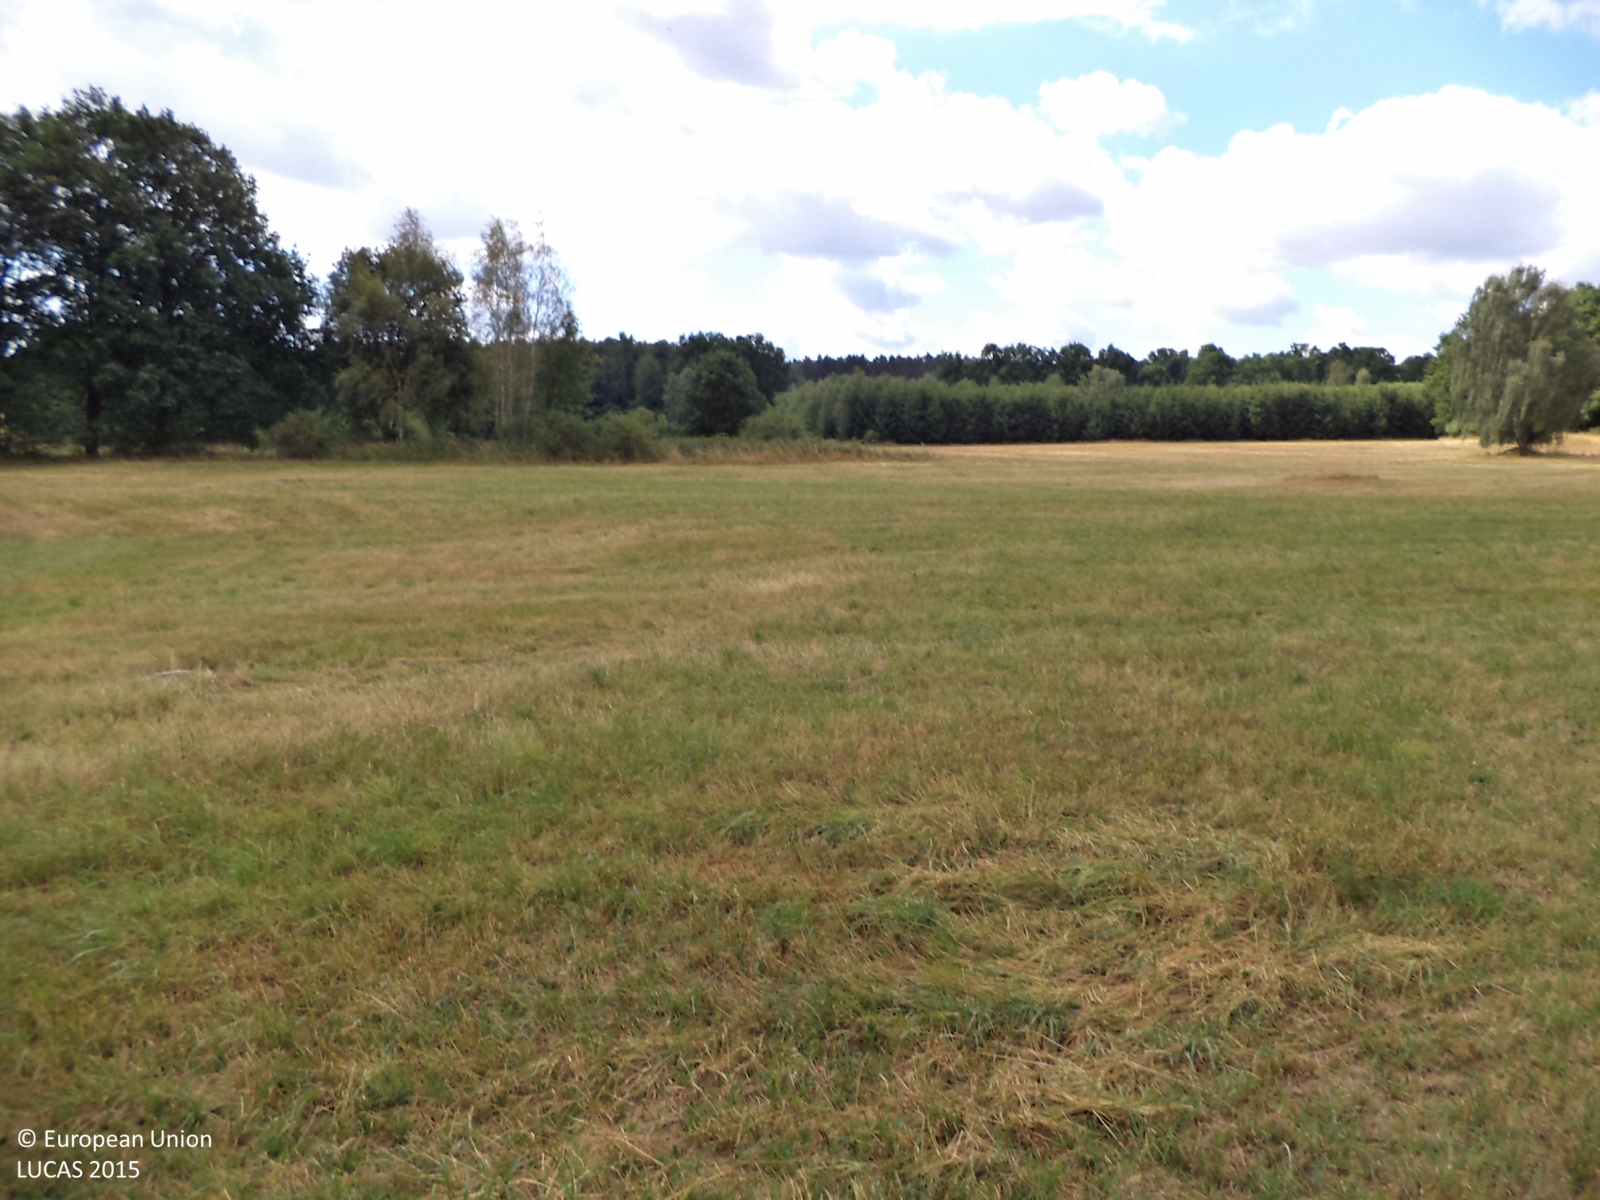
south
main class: Grassland
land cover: Grassland without tree/shrub cover
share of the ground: > 75 %
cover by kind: herbaceous plants 100 %
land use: Agriculture (excluding fallow land and kitchen gardens)
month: July
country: CZ
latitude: 49.6821
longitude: 14.4782
